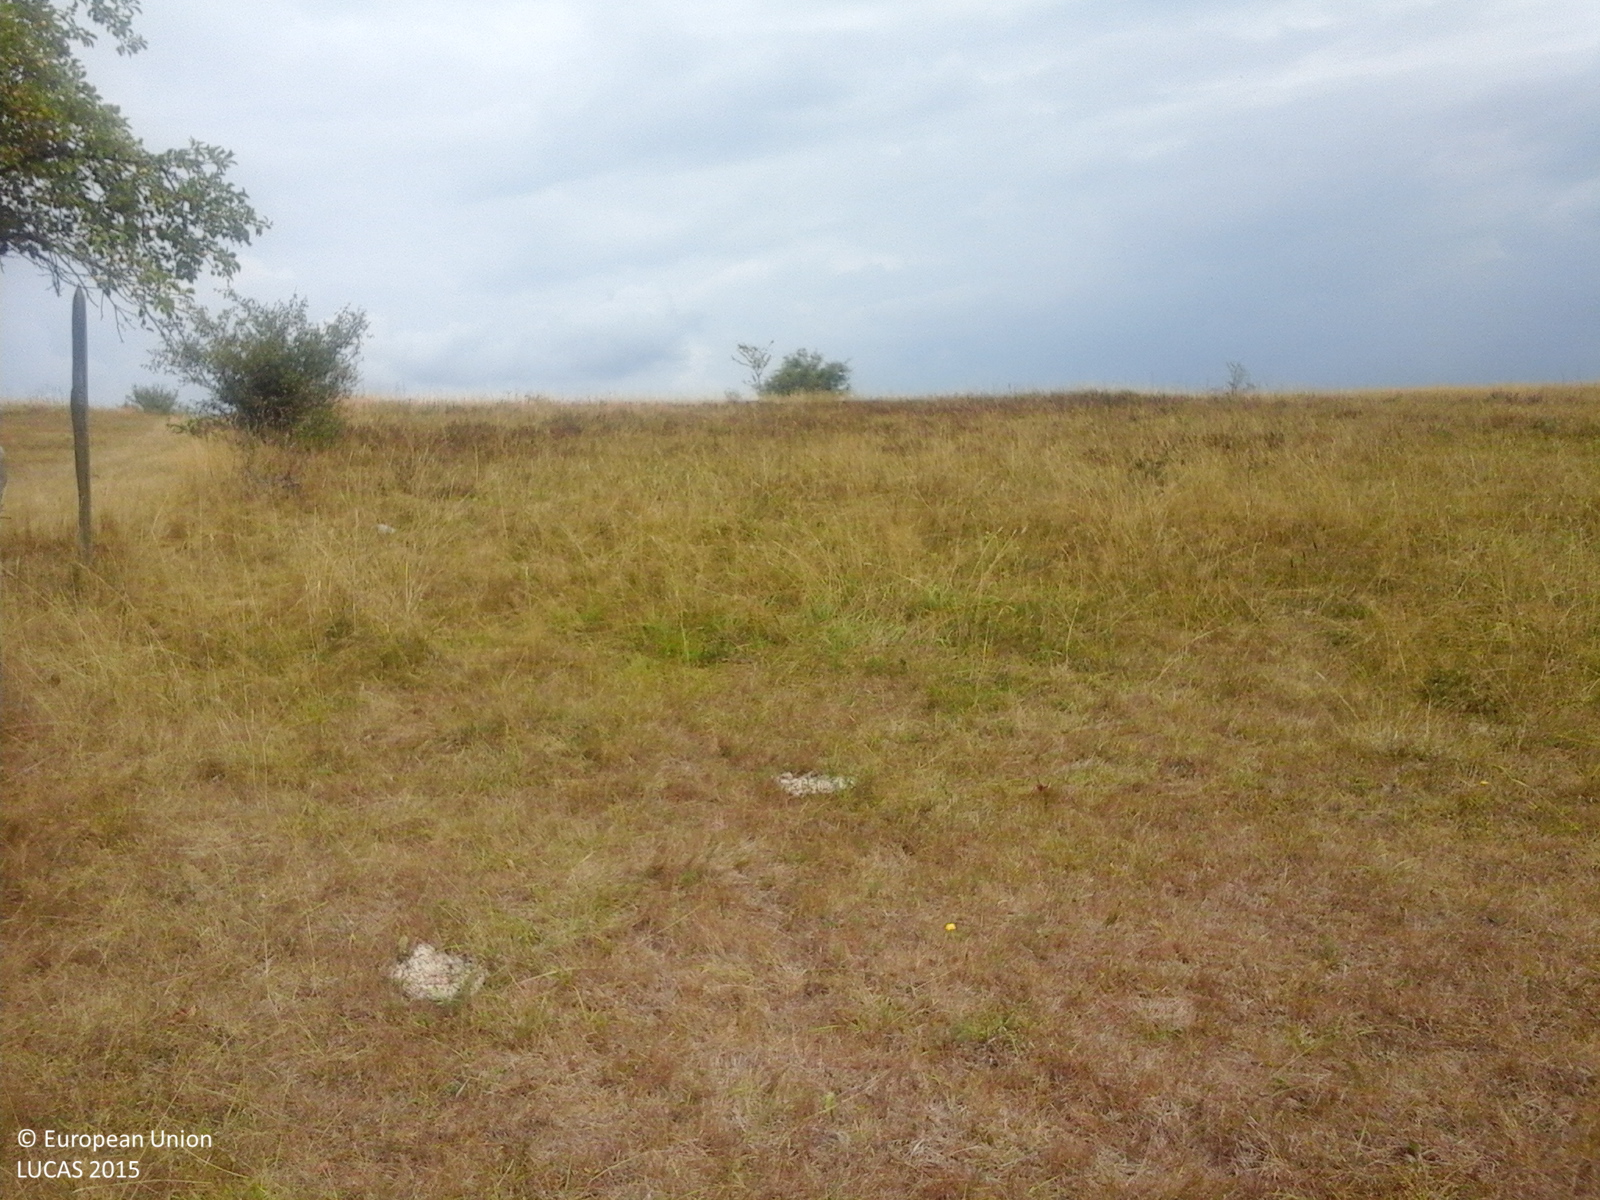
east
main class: Grassland
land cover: Grassland without tree/shrub cover
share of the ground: > 75 %
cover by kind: herbaceous plants 100 %
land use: Agriculture (excluding fallow land and kitchen gardens)
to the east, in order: Grassland without tree/shrub cover; Spontaneously vegetated surfaces; Other fruit trees and berries; Grassland with sparse tree/shrub cover; Abandoned hedges
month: August
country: RO
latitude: 44.8955
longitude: 22.7199
